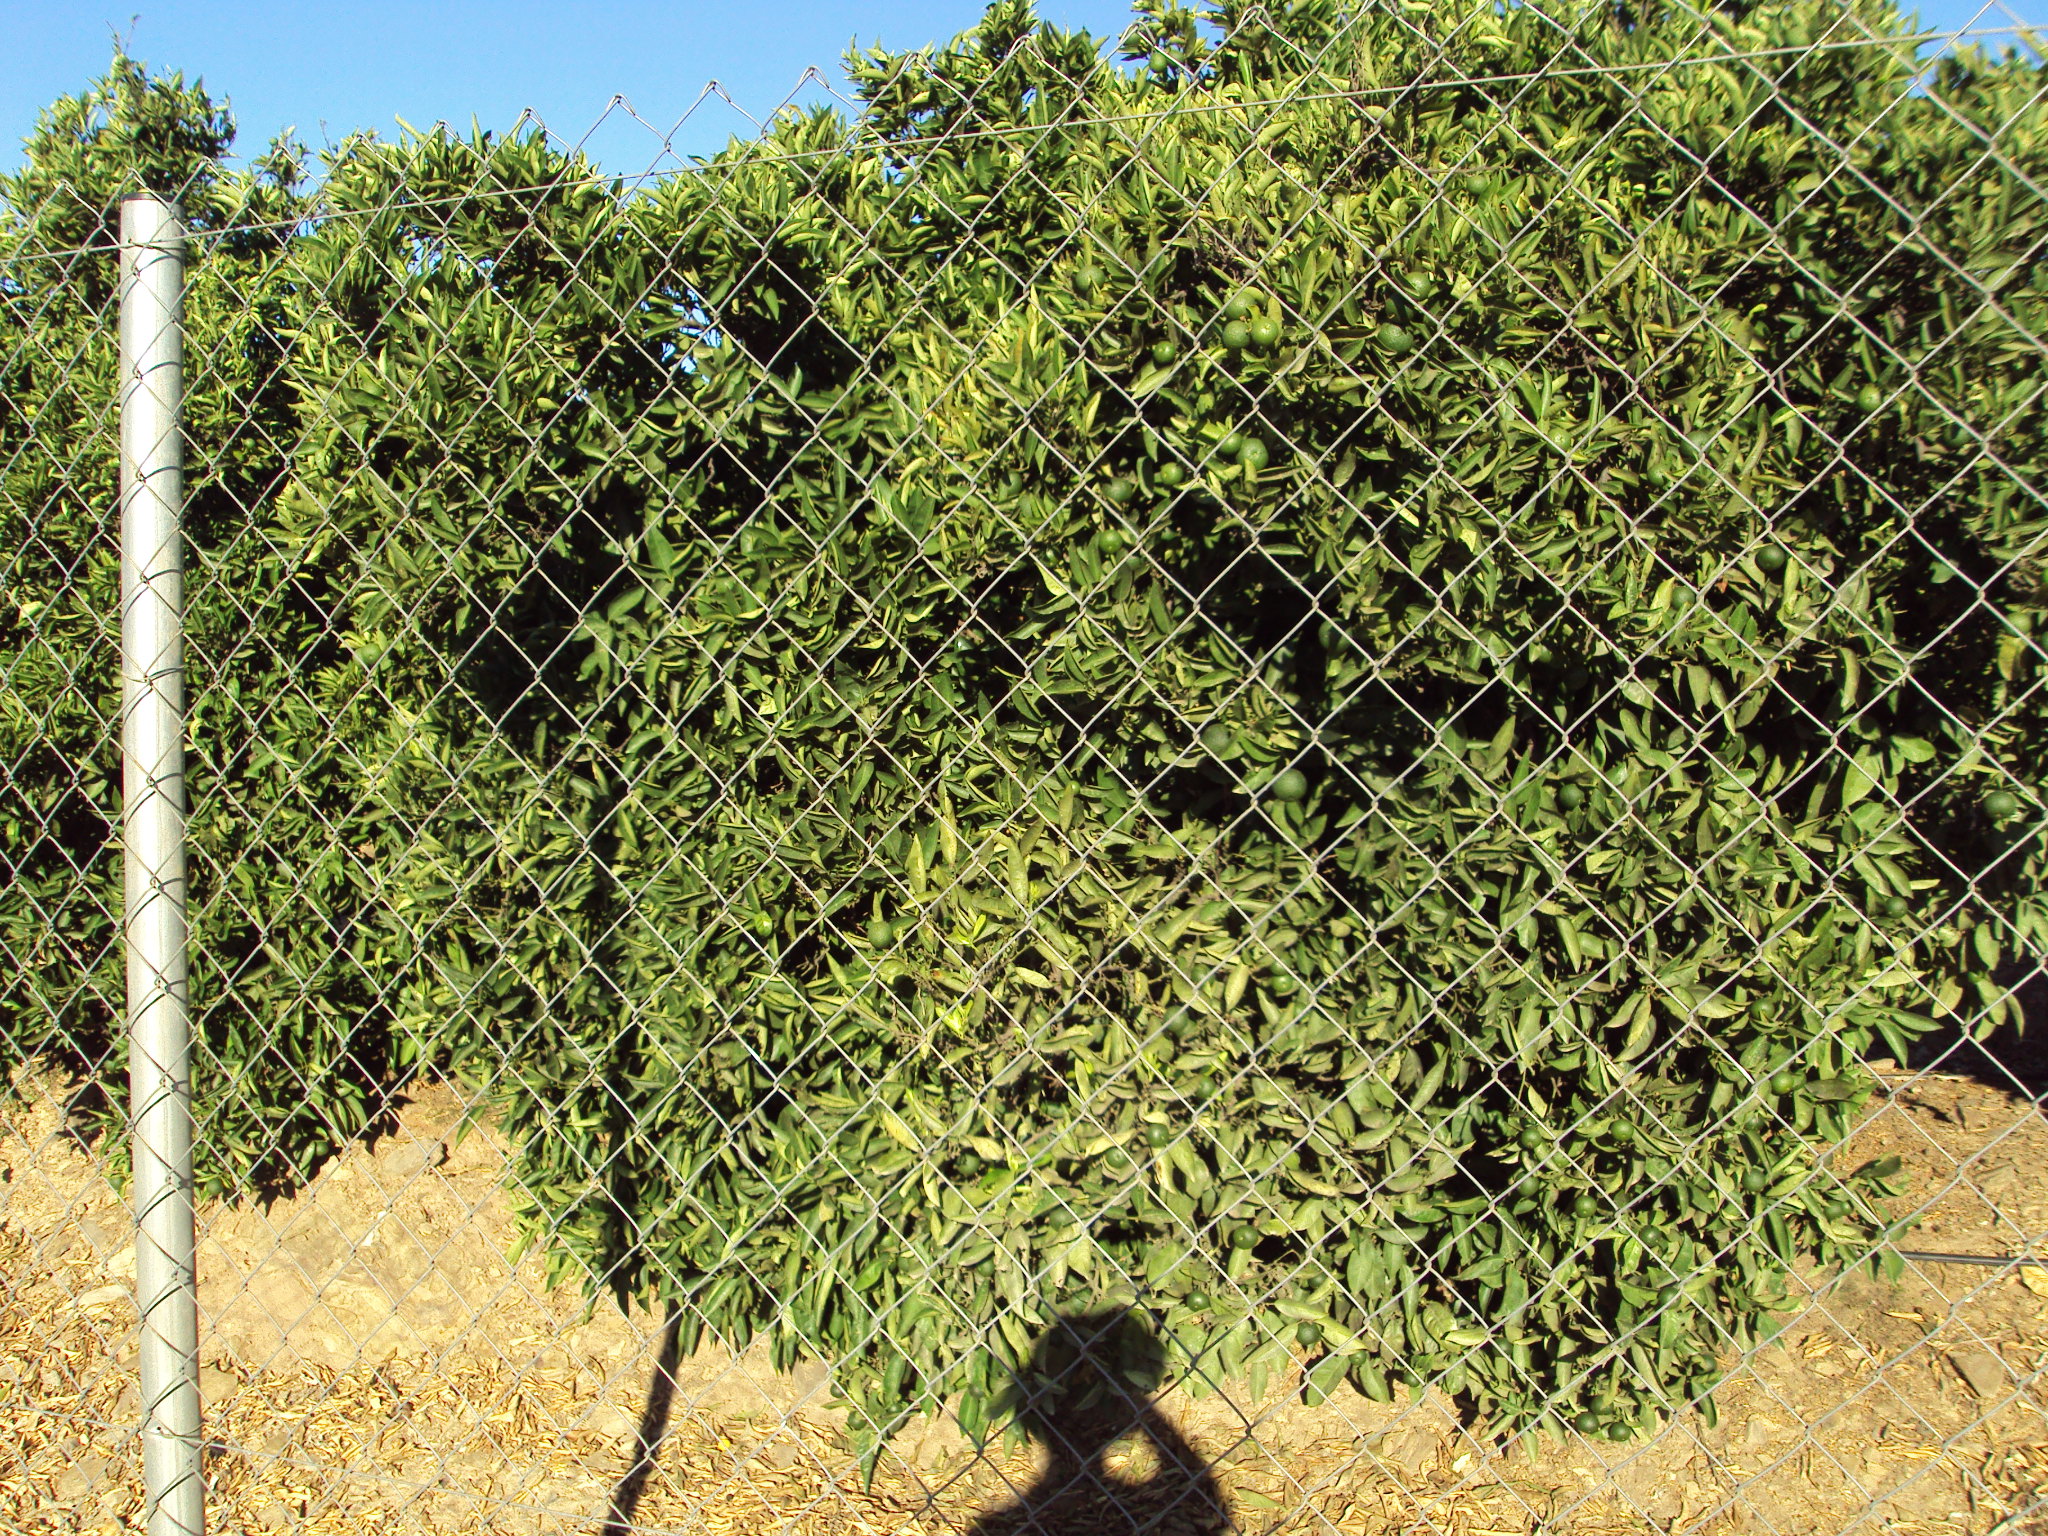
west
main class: Cropland
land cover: Oranges
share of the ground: > 75 %
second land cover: Other bare soil
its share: > 75 %
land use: Agriculture (excluding fallow land and kitchen gardens)
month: July
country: ES
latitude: 37.4153
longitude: -7.0480
